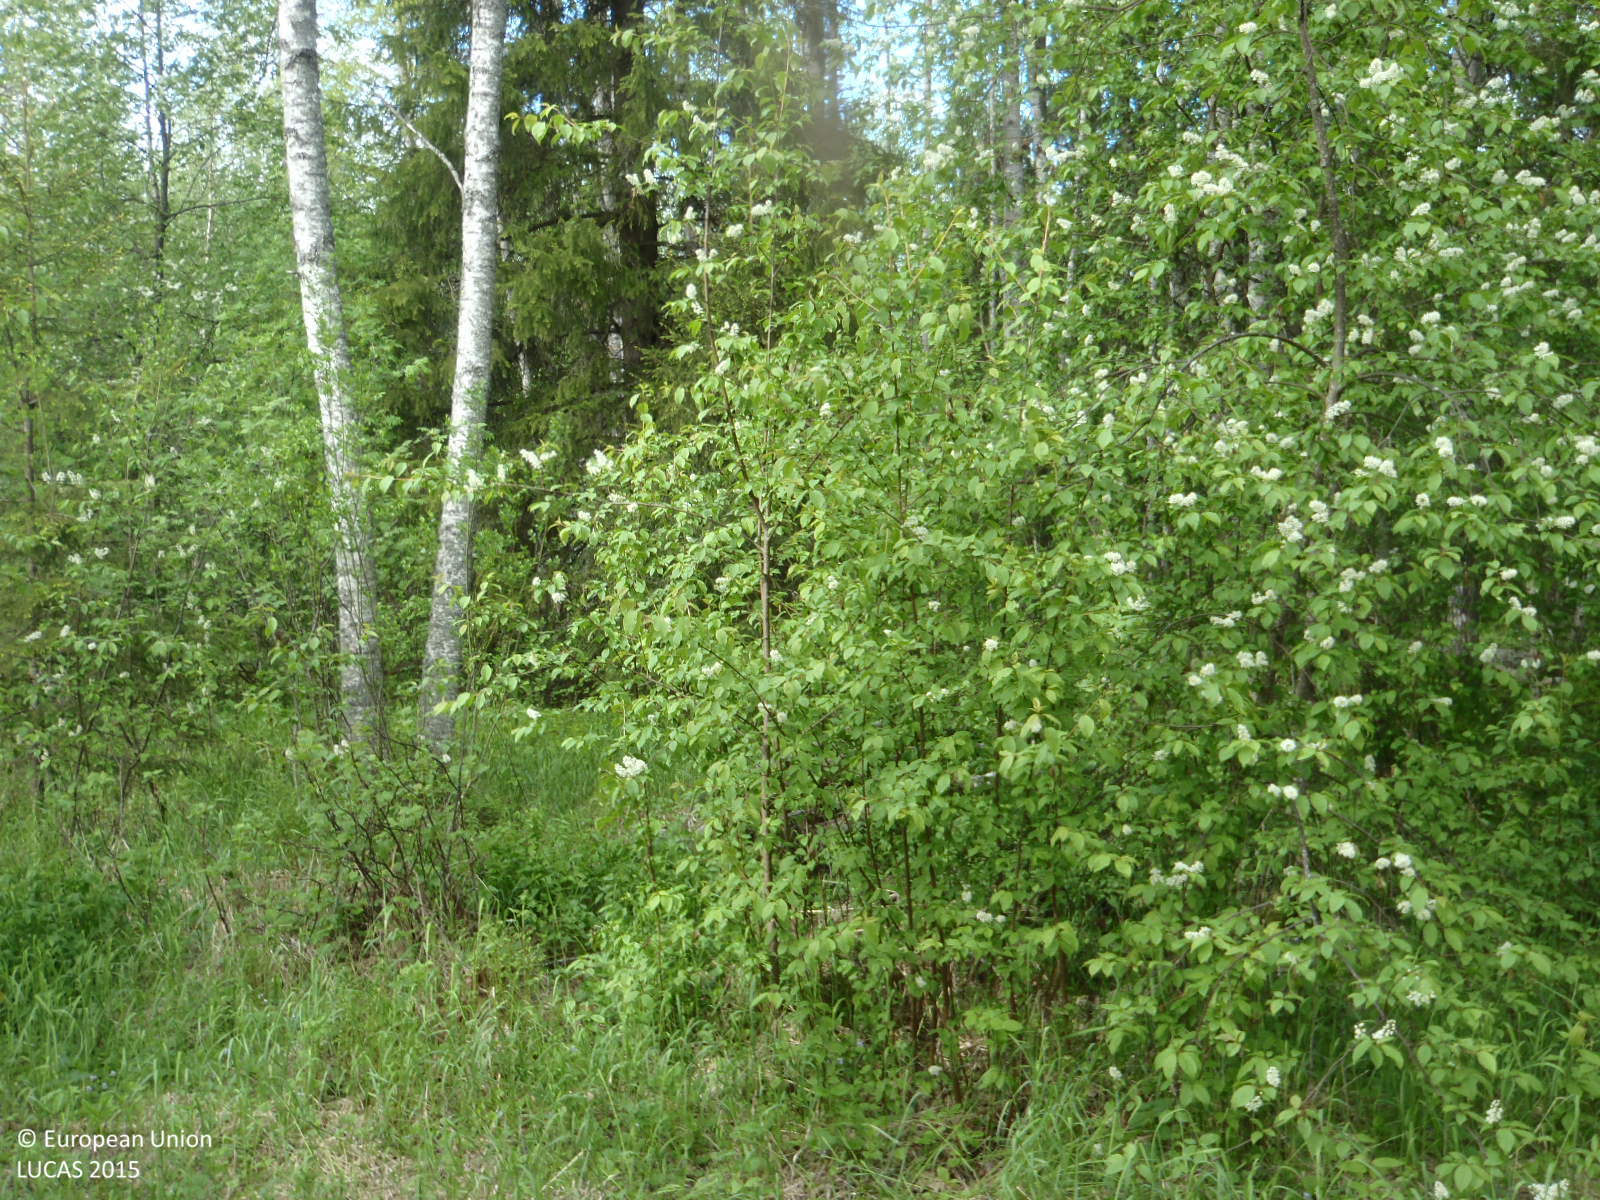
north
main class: Woodland
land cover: Other mixed woodland
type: boreal forest
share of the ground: > 75 %
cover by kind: broadleaved forest trees 40 %, coniferous forest trees 35 %, shrubs 20 %, herbaceous plants 5 %
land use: Forestry
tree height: > 5 m
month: June
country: FI
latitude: 64.9553
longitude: 25.5620
